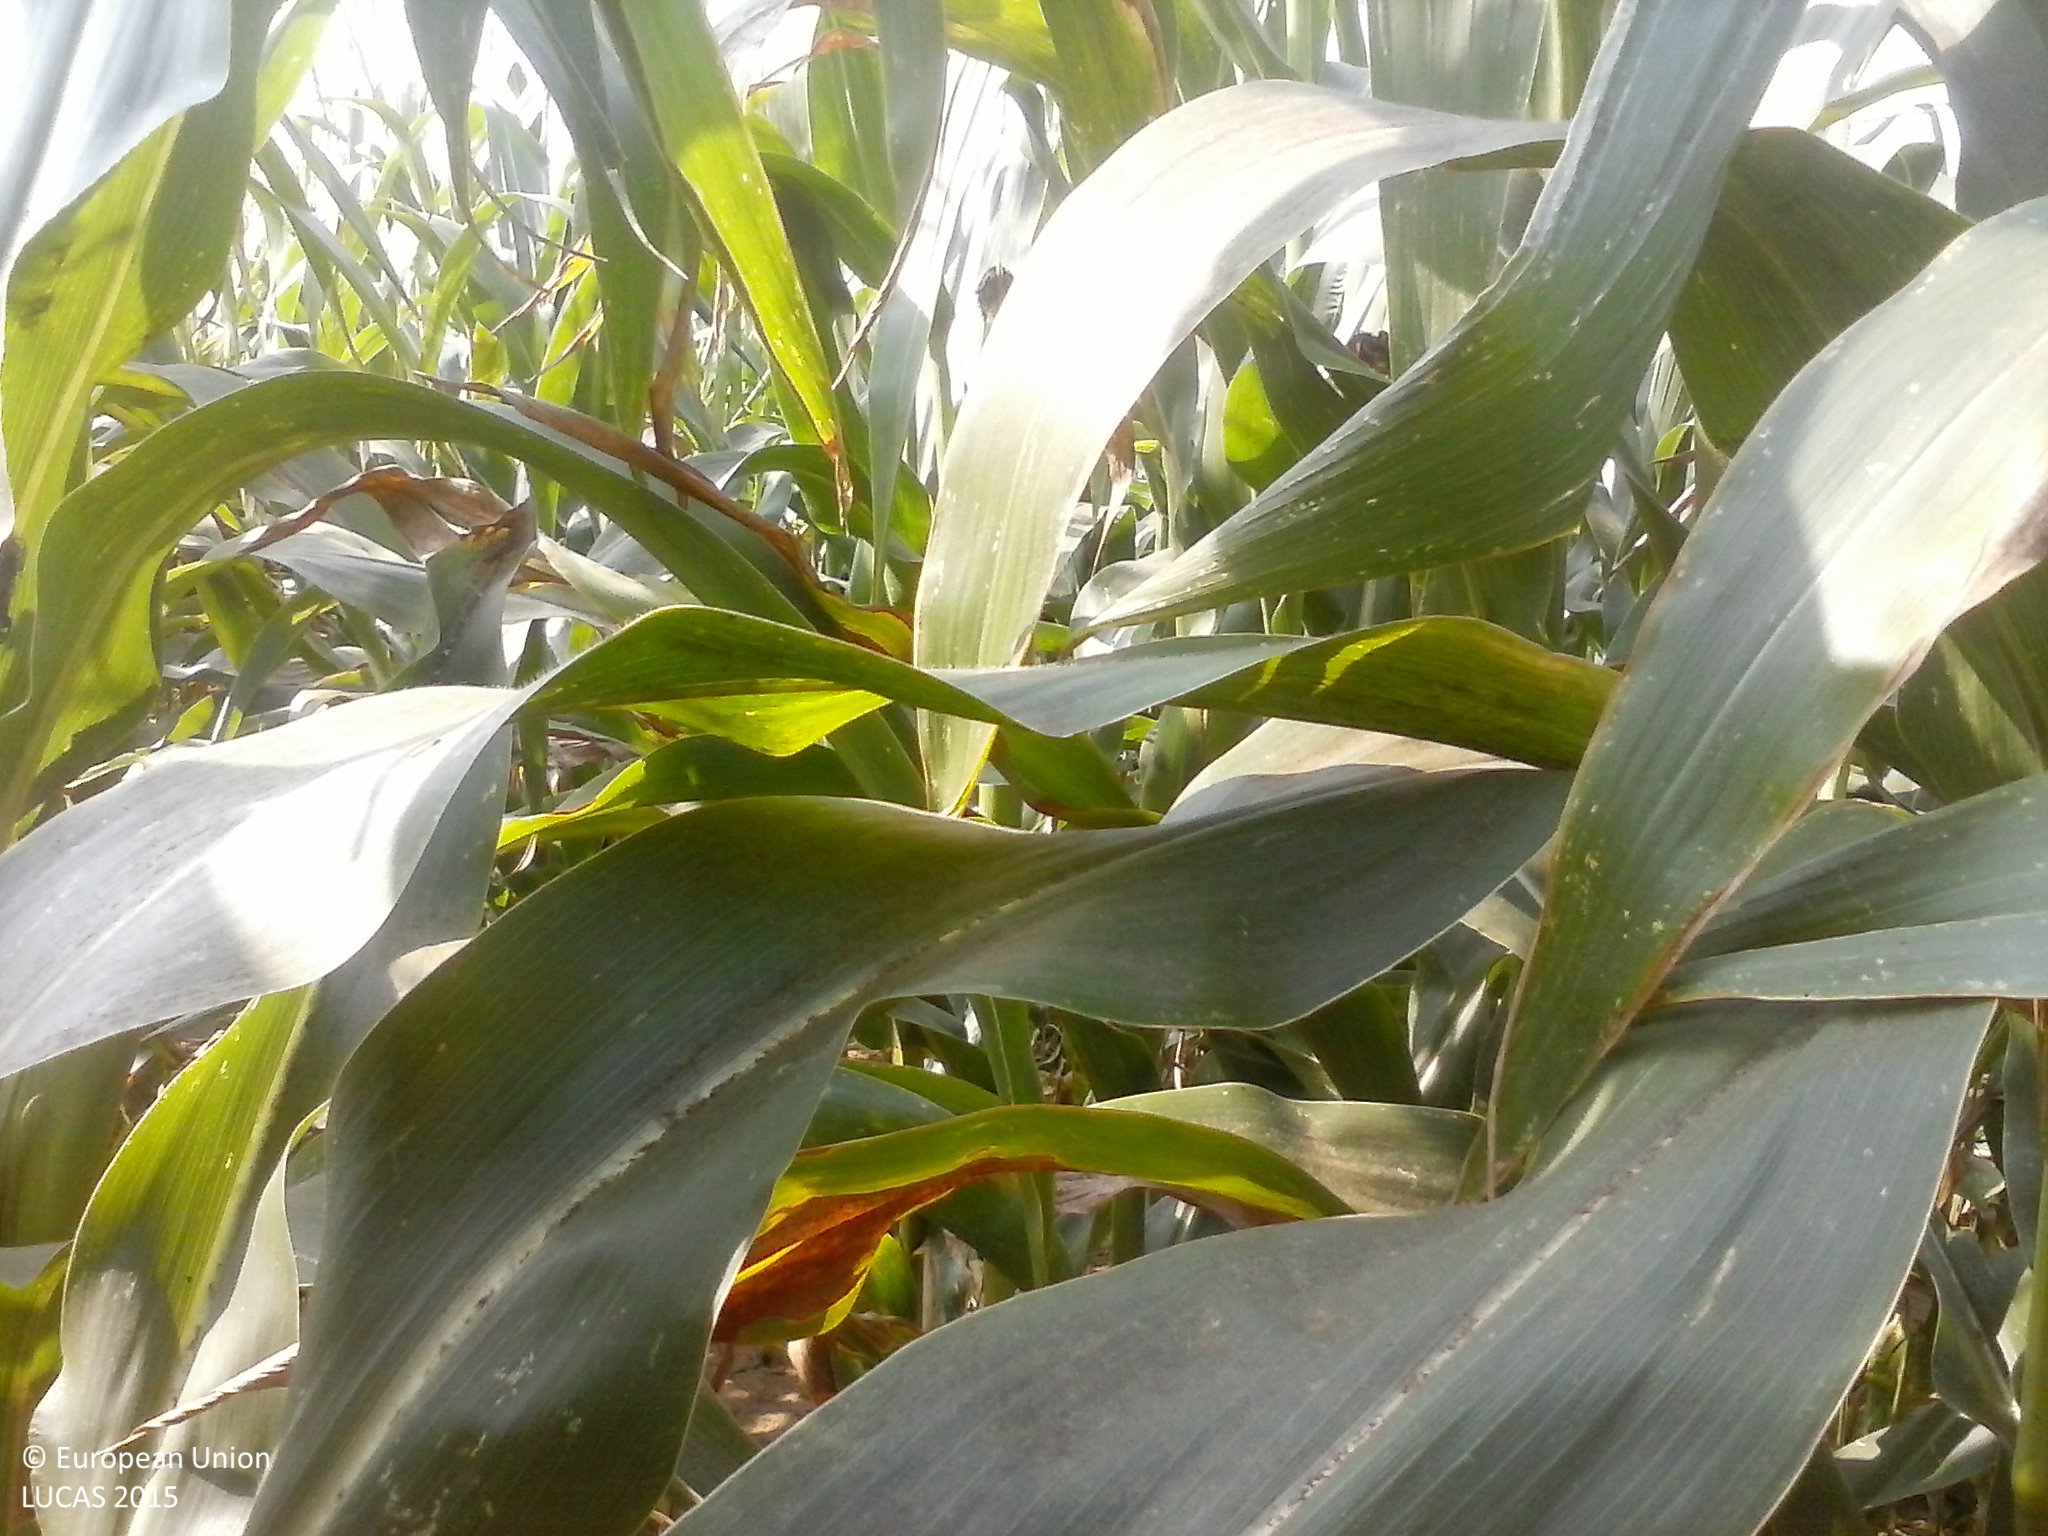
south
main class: Cropland
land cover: Maize
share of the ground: > 75 %
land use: Agriculture (excluding fallow land and kitchen gardens)
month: August
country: HU
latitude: 46.1895
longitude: 17.8443
